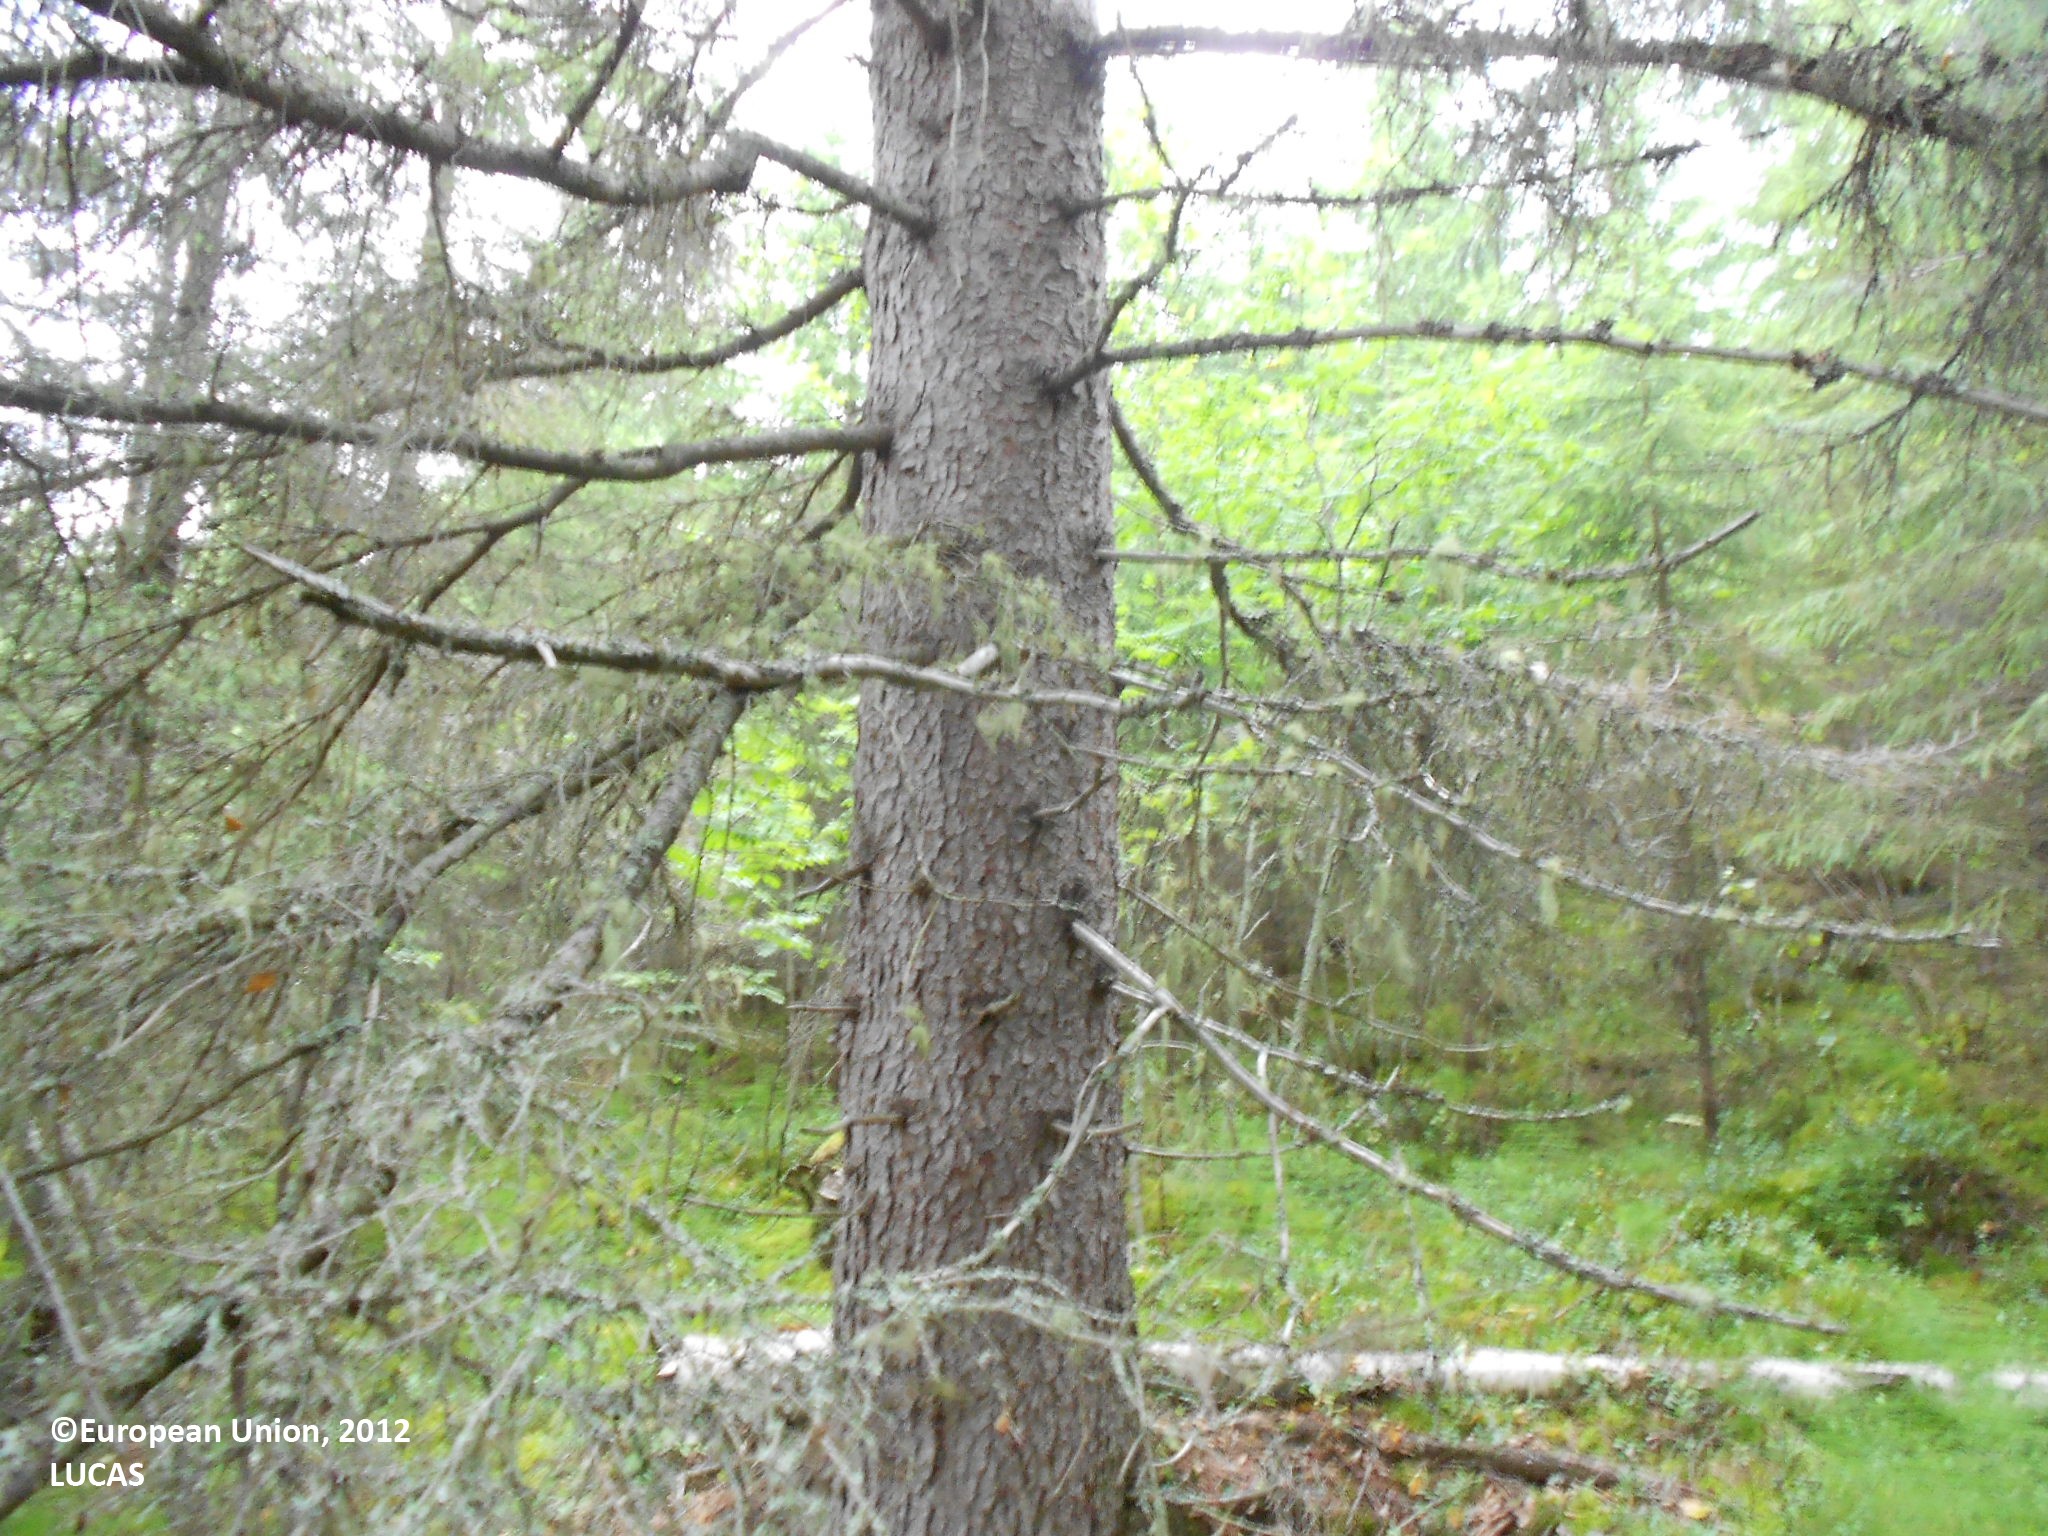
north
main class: Woodland
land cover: Spruce dominated coniferous woodland
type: boreal forest
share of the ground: > 75 %
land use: Forestry
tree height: > 5 m
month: August
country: FI
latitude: 63.5318
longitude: 28.8435
